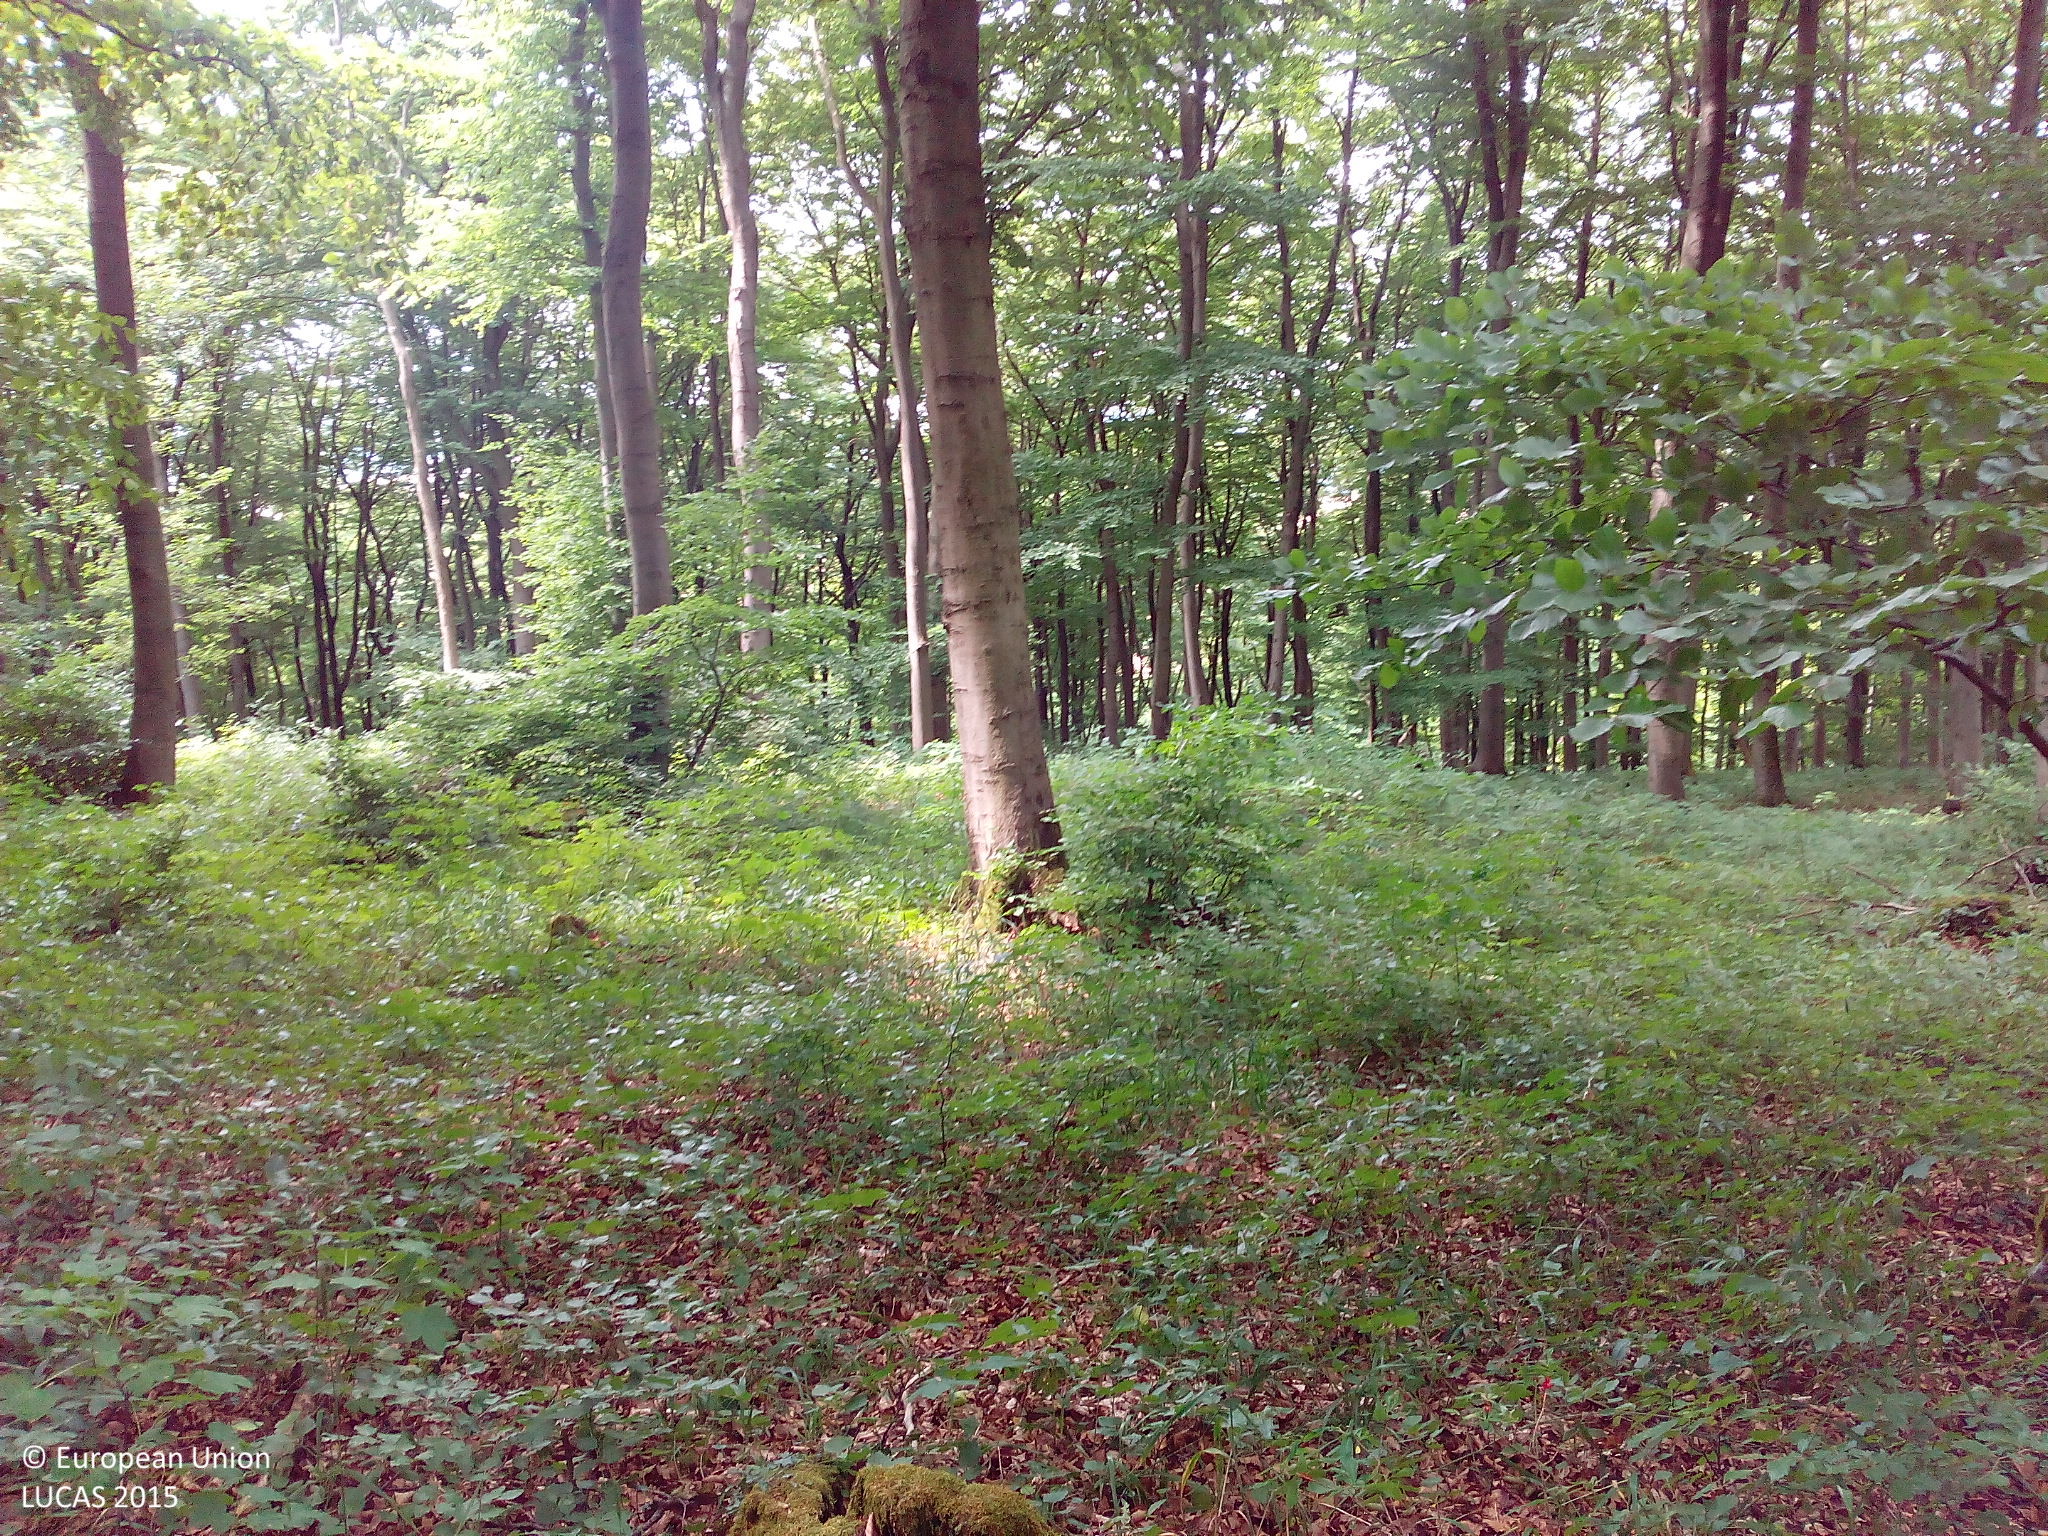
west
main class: Woodland
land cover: Broadleaved woodland
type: beech forest
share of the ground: > 75 %
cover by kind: broadleaved forest trees 90 %, herbaceous plants 10 %
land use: Forestry
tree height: > 5 m
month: July
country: DE
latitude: 50.8314
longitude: 9.8723
